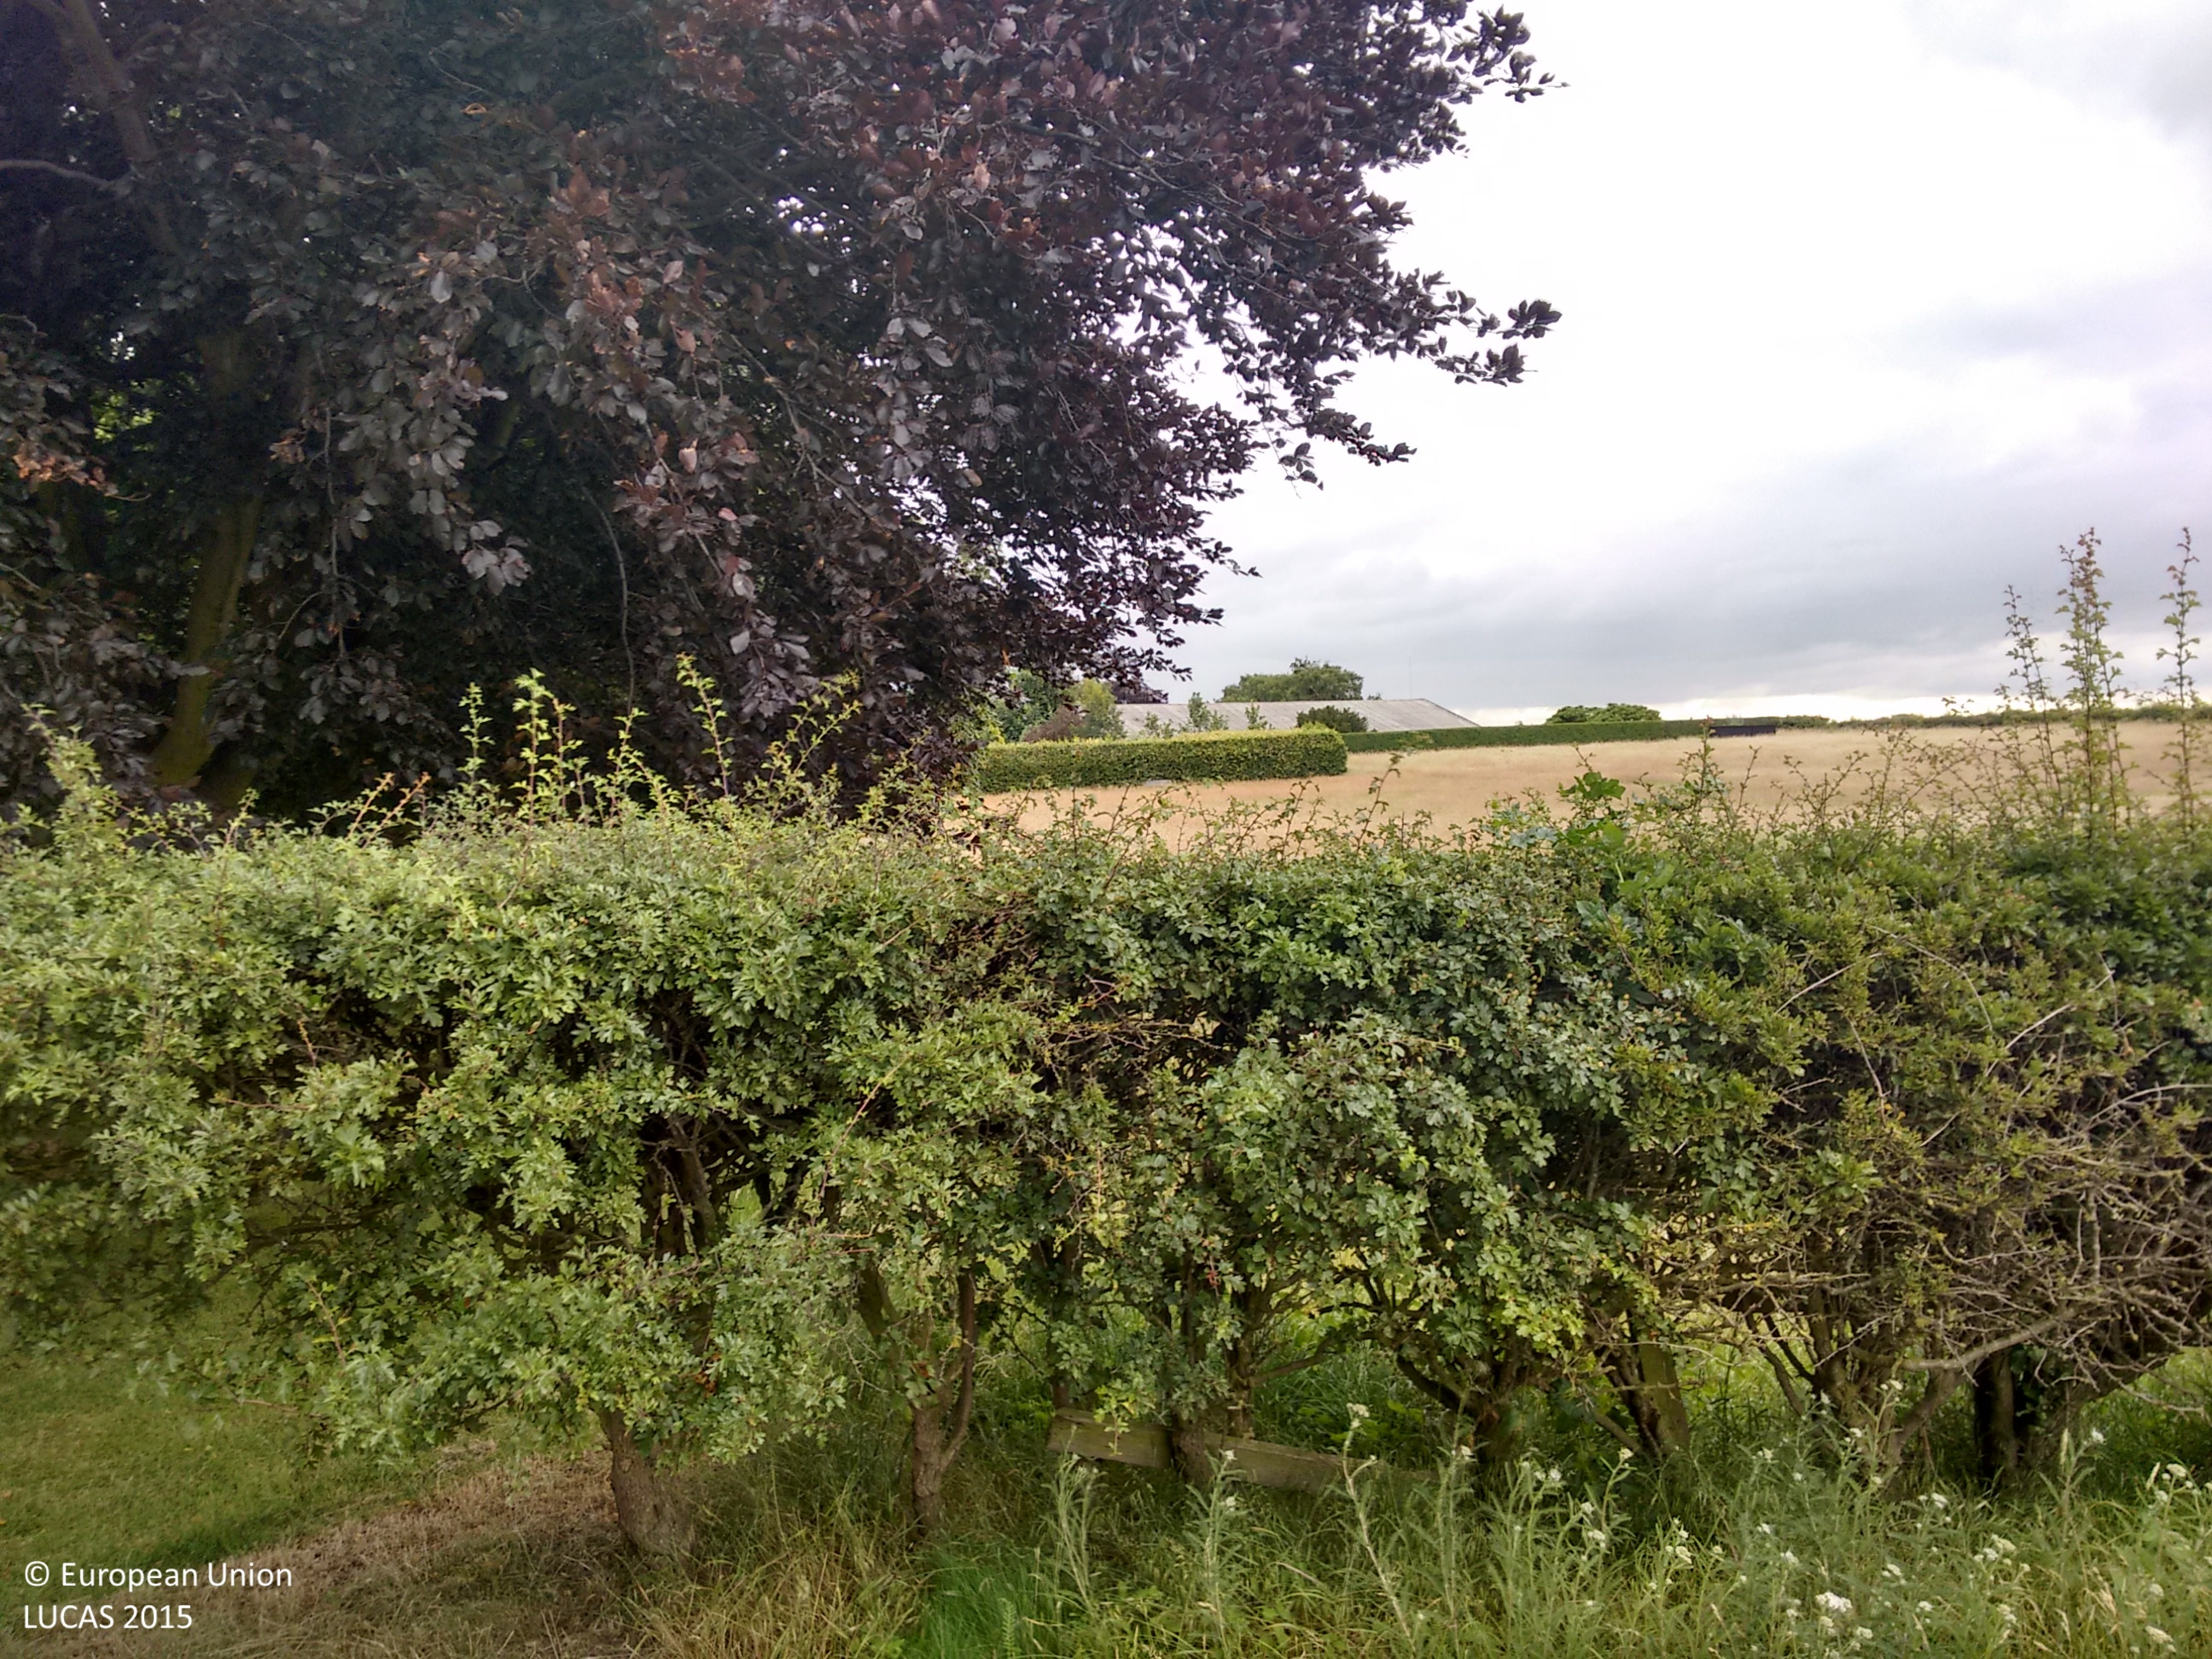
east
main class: Cropland
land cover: Potatoes
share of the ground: > 75 %
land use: Agriculture (excluding fallow land and kitchen gardens)
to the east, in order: Potatoes; Grass margins; Tracks; Grass margins; Permanent crops (only in case pi)
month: July
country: GB
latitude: 53.3656
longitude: -1.0598
